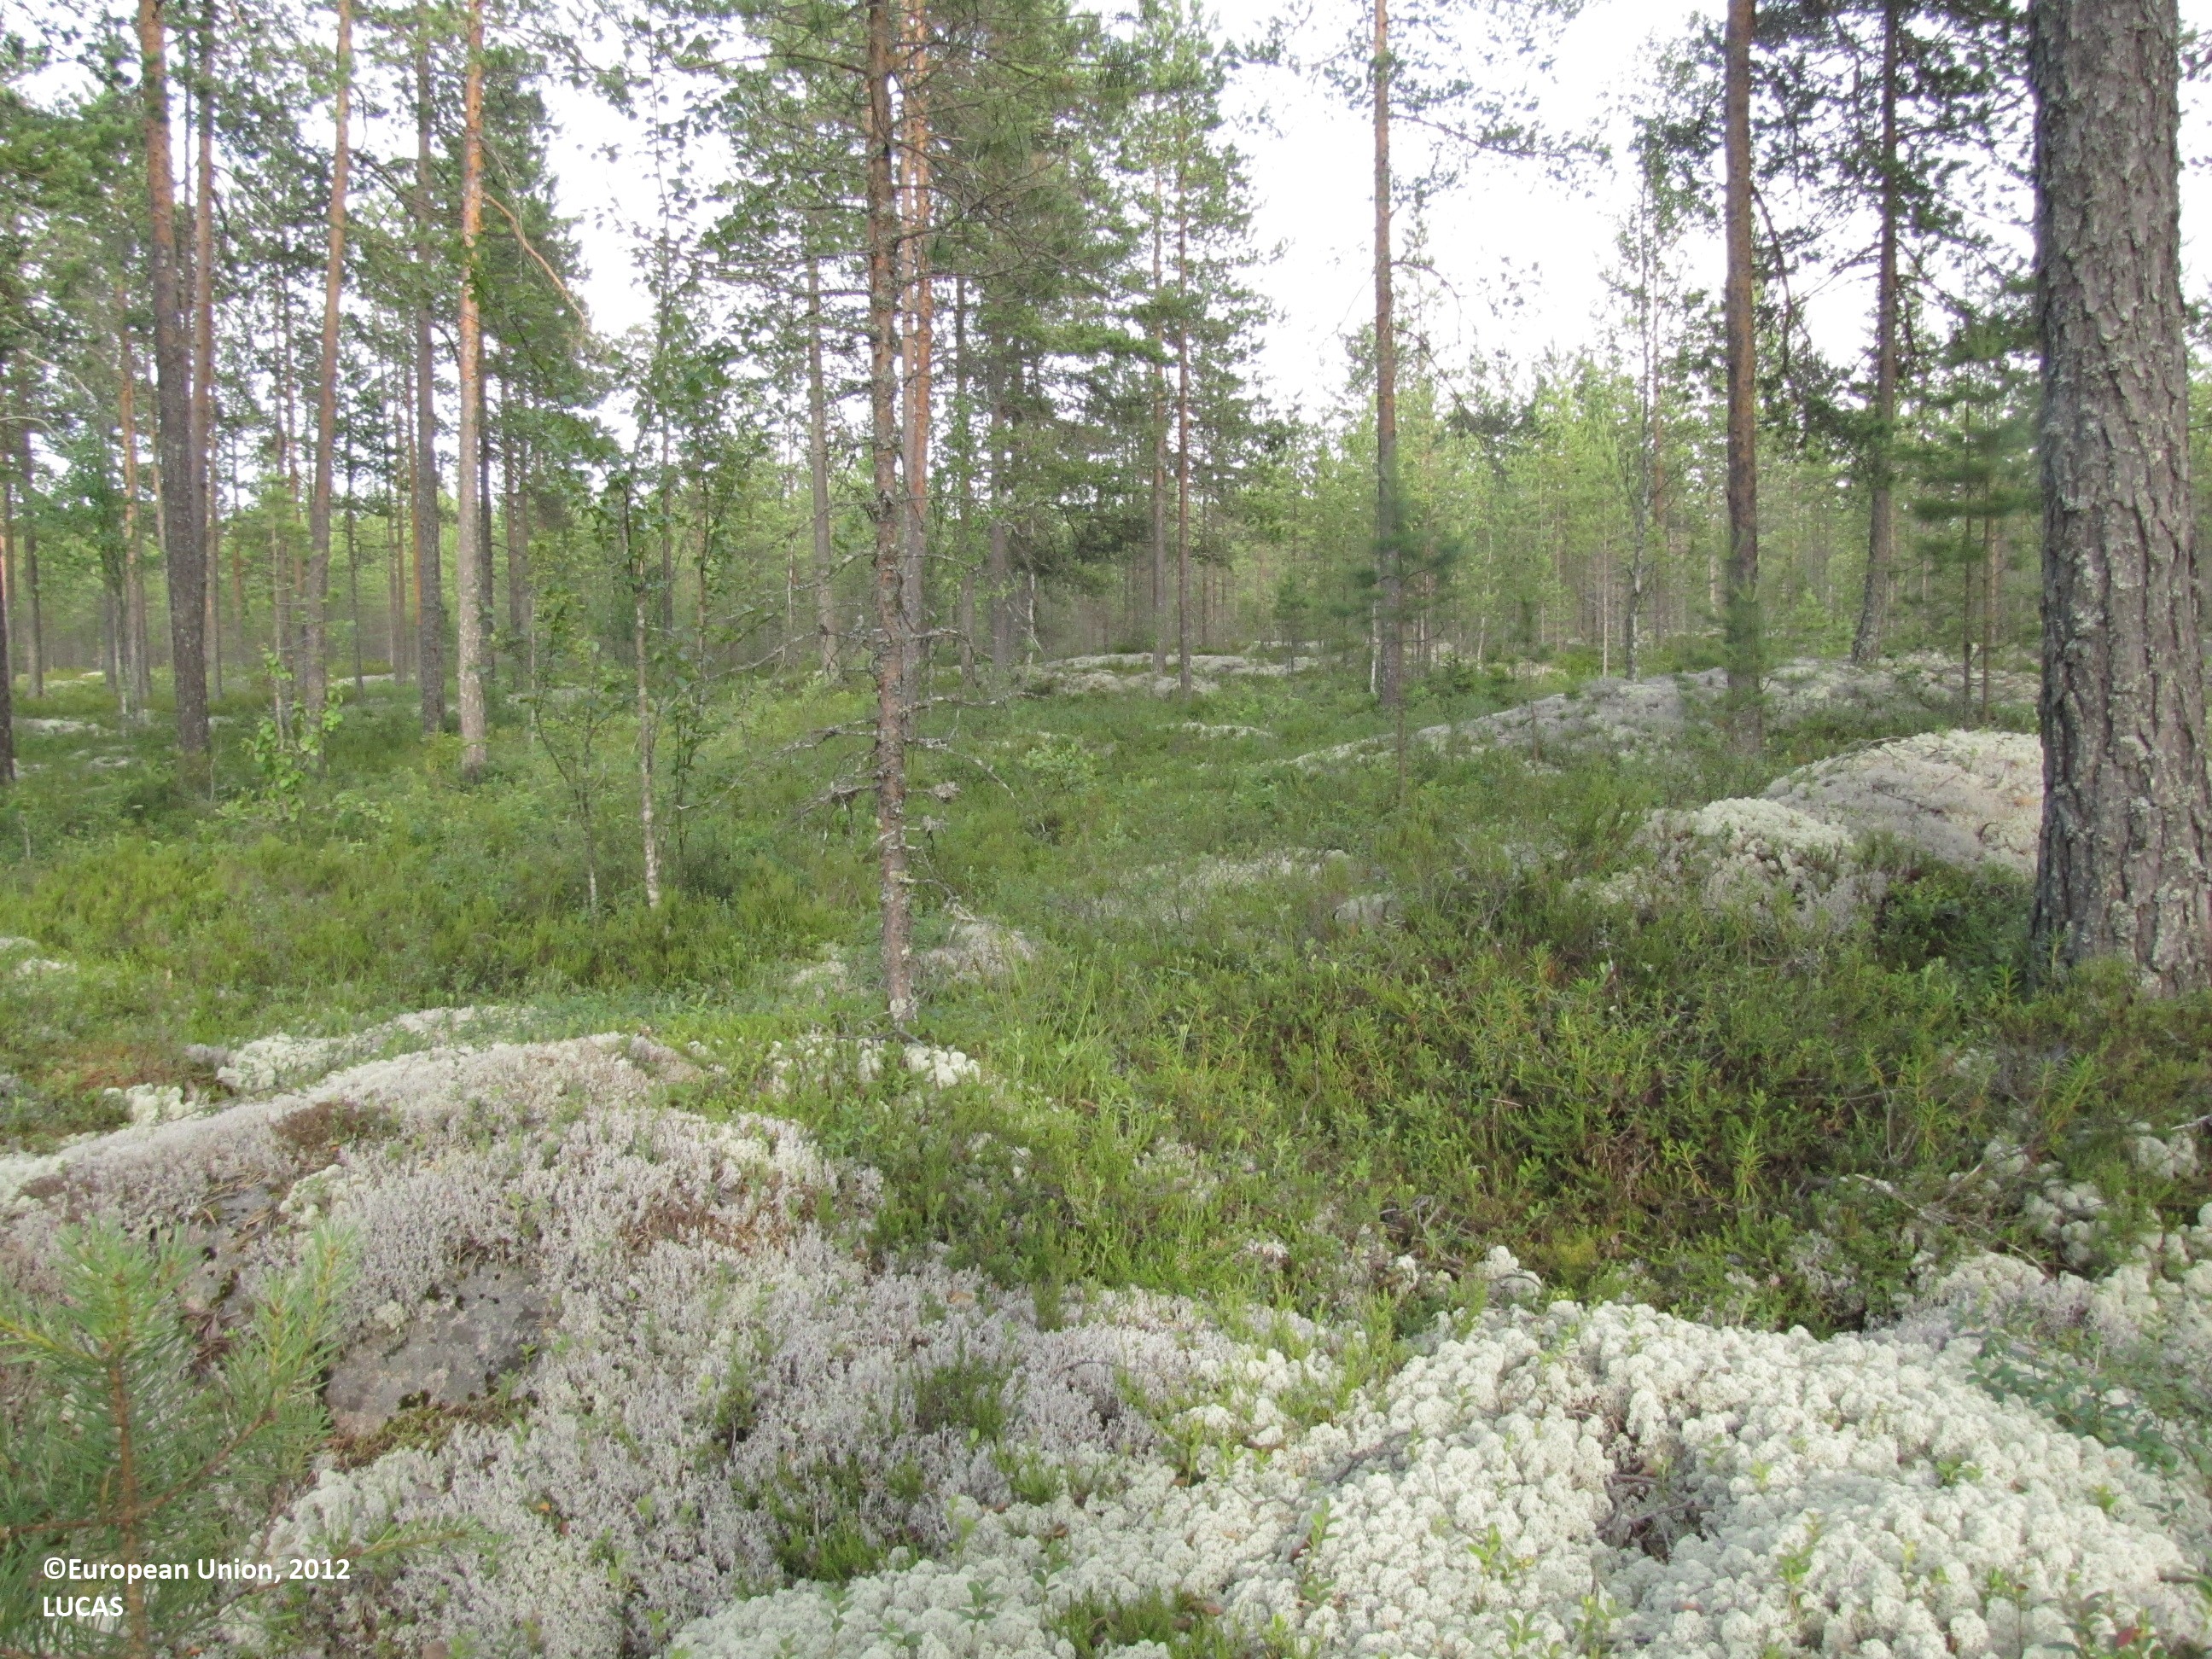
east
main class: Woodland
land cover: Pine dominated coniferous woodland
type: boreal forest
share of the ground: > 75 %
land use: Forestry
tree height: > 5 m
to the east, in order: Pine dominated coniferous woodland; Pine dominated mixed woodland
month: July
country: FI
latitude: 62.5259
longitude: 23.5756
